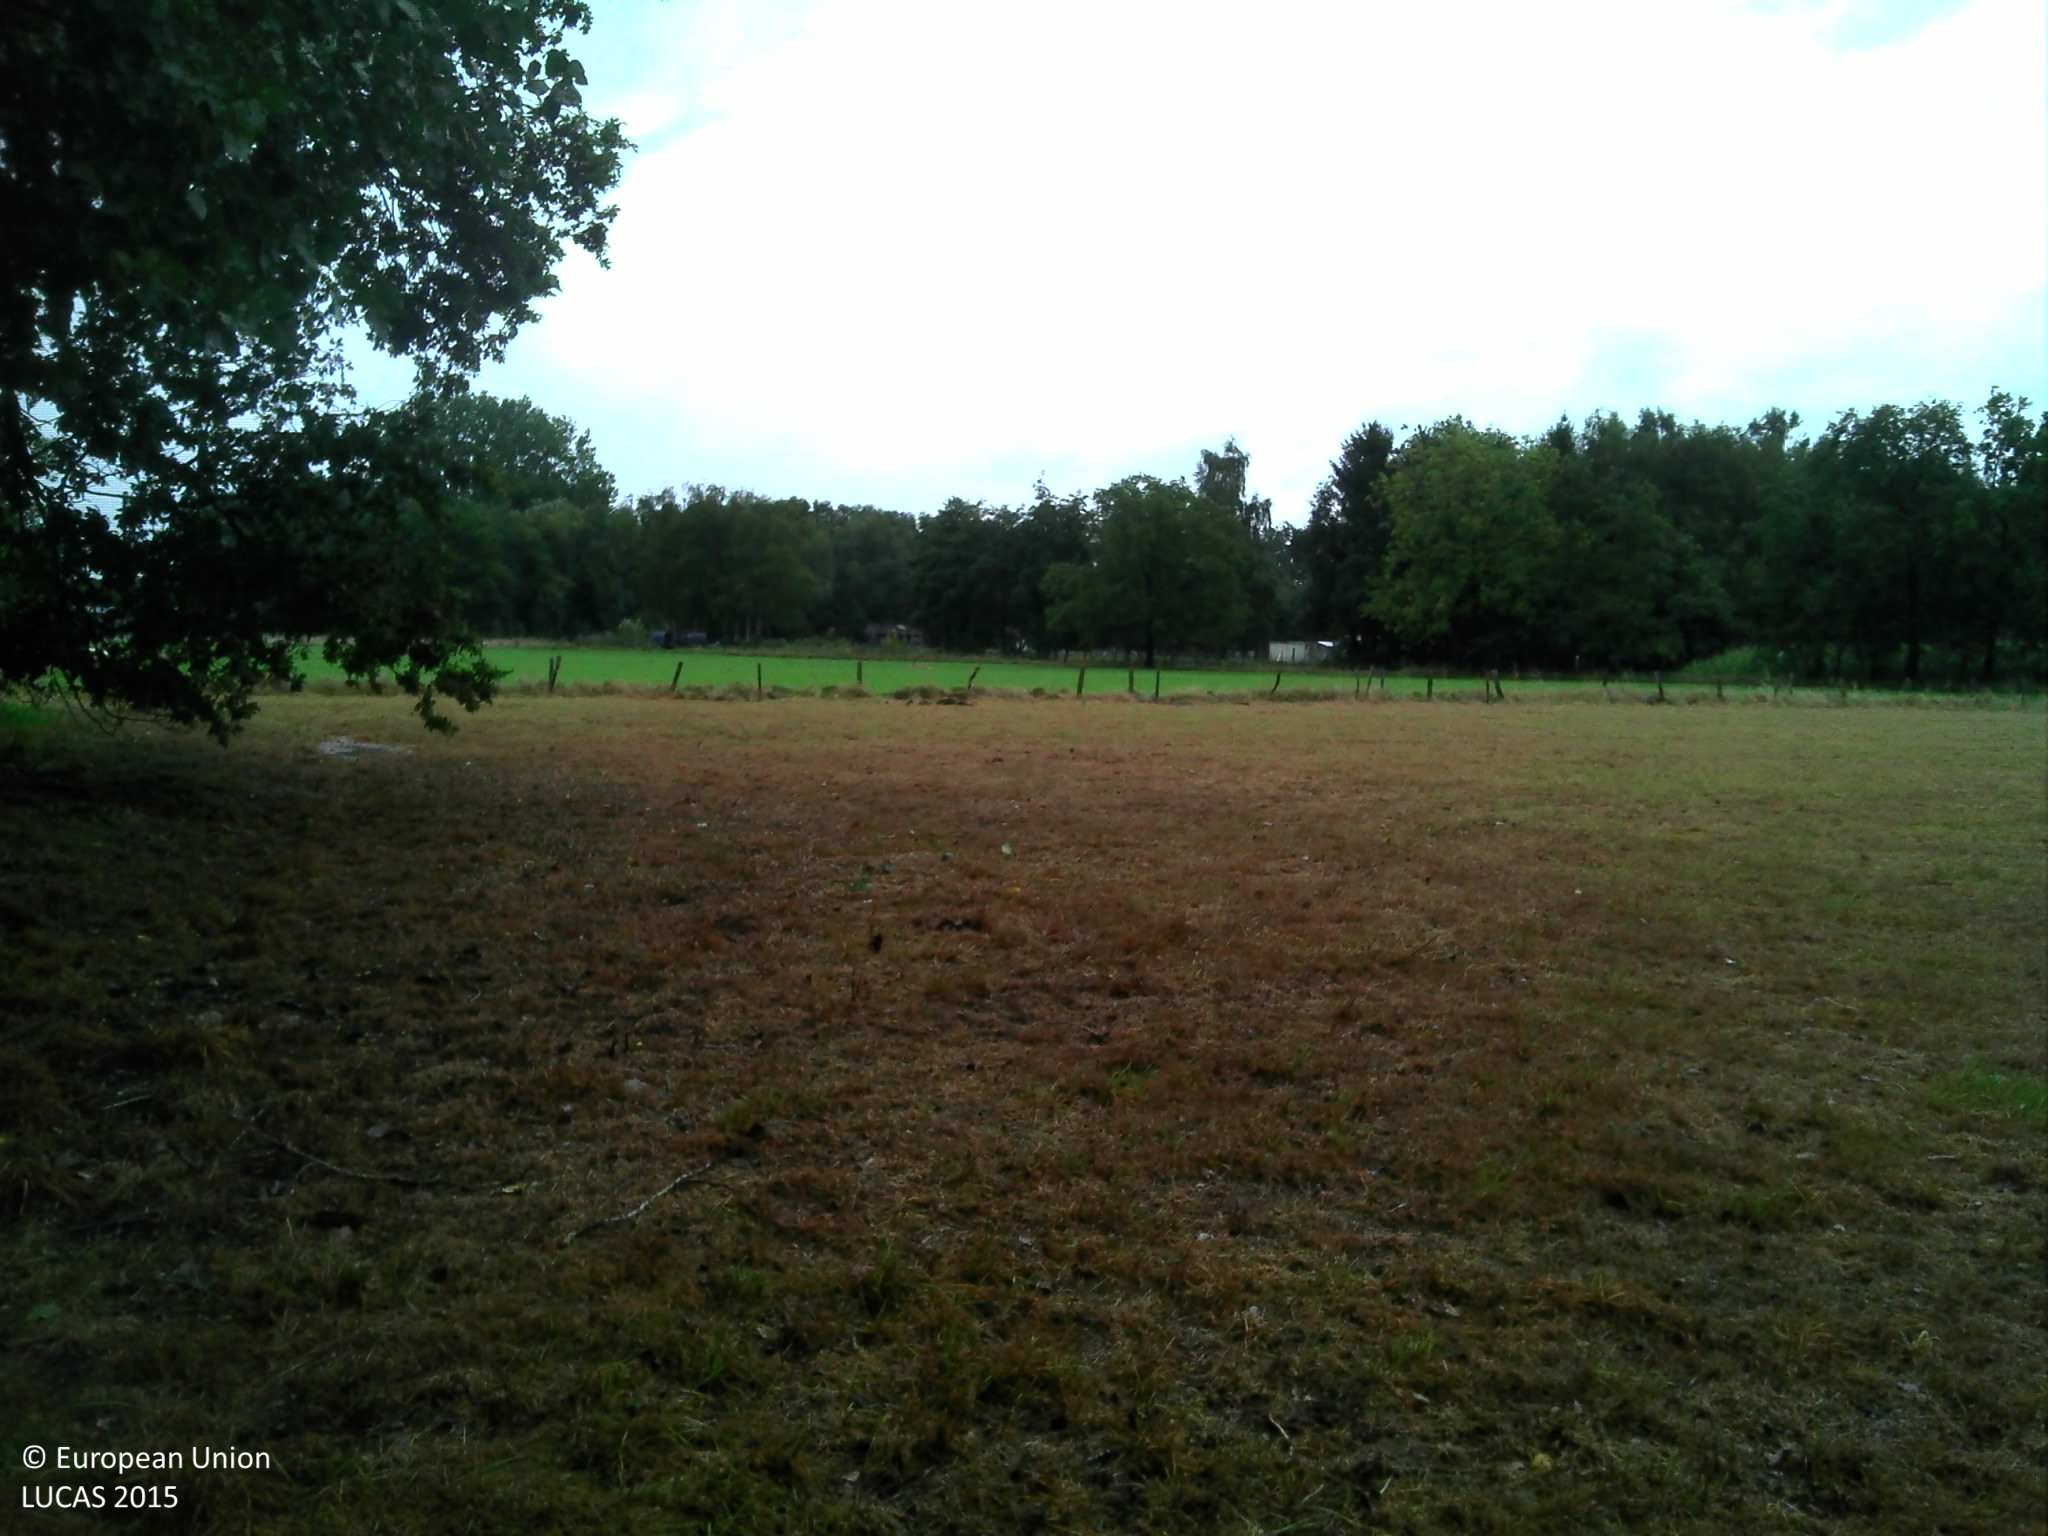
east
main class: Grassland
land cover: Grassland without tree/shrub cover
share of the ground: > 75 %
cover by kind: herbaceous plants 100 %
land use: Agriculture (excluding fallow land and kitchen gardens)
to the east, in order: Grassland without tree/shrub cover; Fences; Temporary grasslands; Fences; Ditches and canals; Grass margins; Paved roads, cycling and walking lanes; Grass margins; Ditches and canals; Grass margins; Fences; Grassland without tree/shrub cover; Artificial constructions in urban areas; Grassland without tree/shrub cover; Fences; Grassland without tree/shrub cover
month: September
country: BE
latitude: 51.2481
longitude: 4.6524
